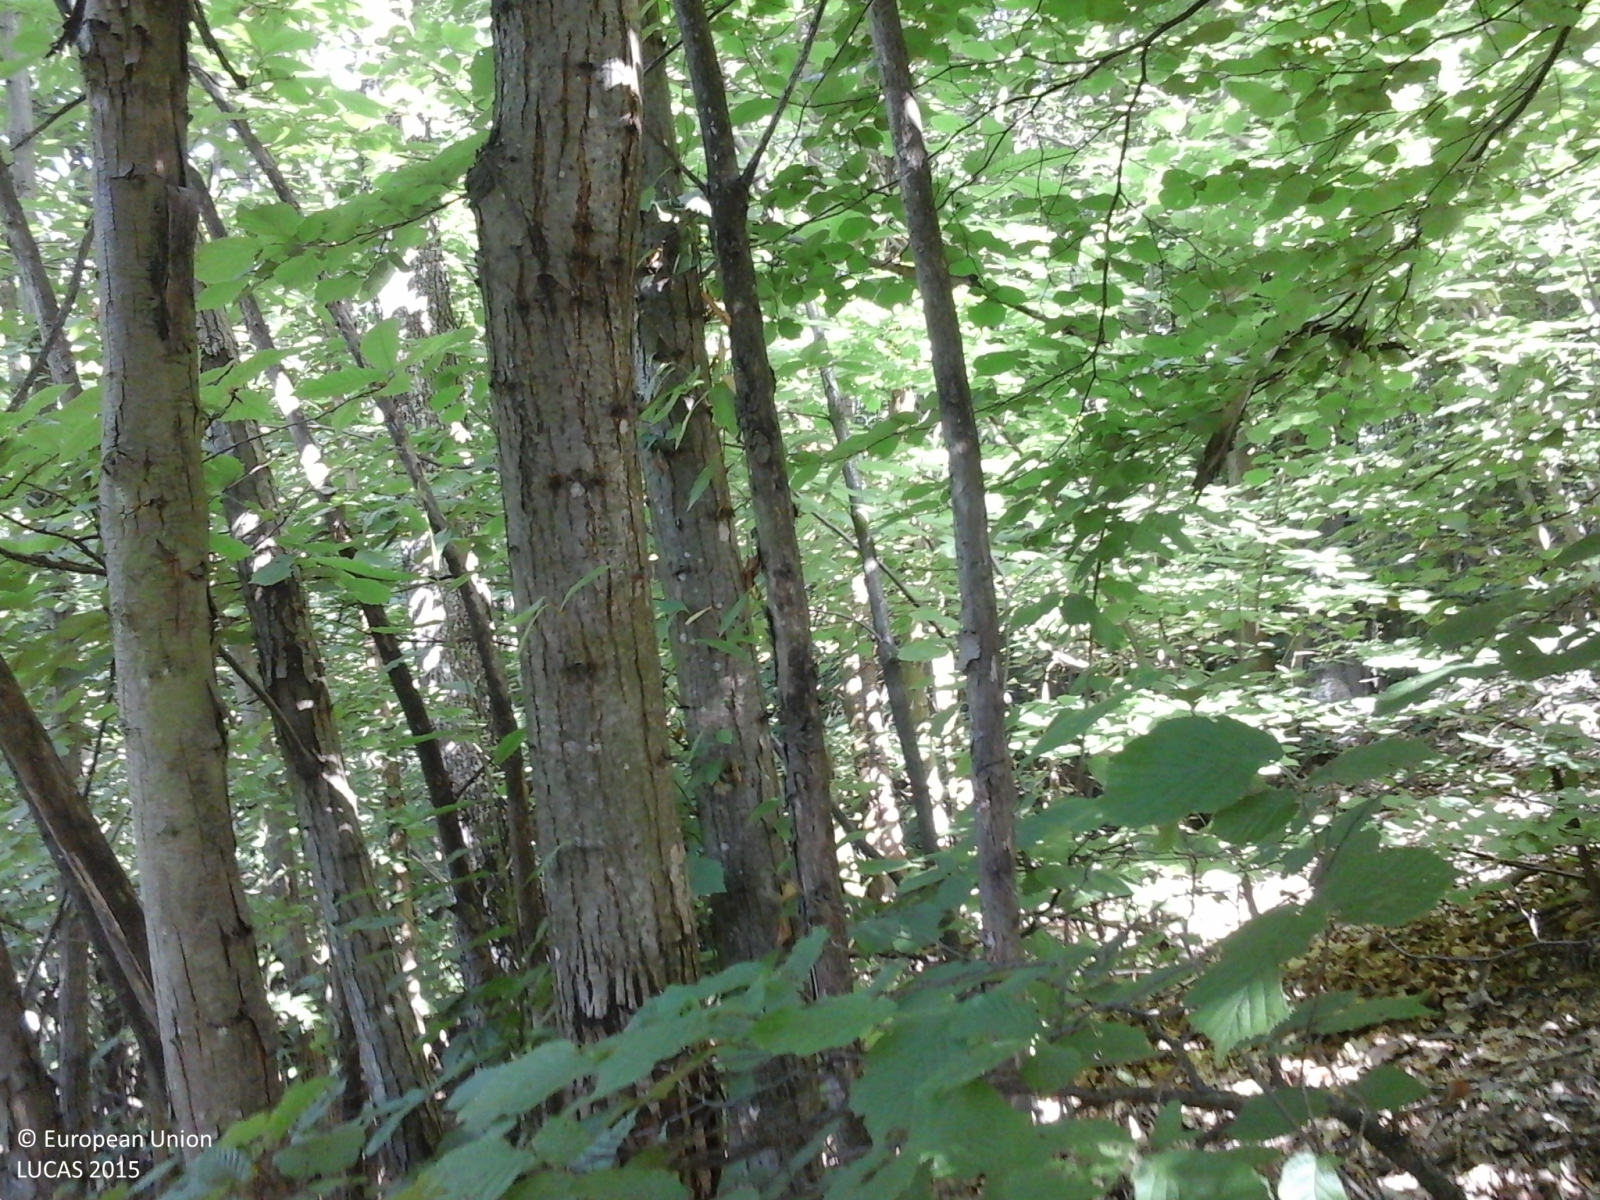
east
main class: Woodland
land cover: Broadleaved woodland
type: thermophilous deciduous forest
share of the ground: > 75 %
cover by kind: broadleaved forest trees 100 %
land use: Forestry
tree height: > 5 m
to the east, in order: Broadleaved woodland; Ditches and canals; Broadleaved woodland
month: June
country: IT
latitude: 44.5884
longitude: 8.2528
